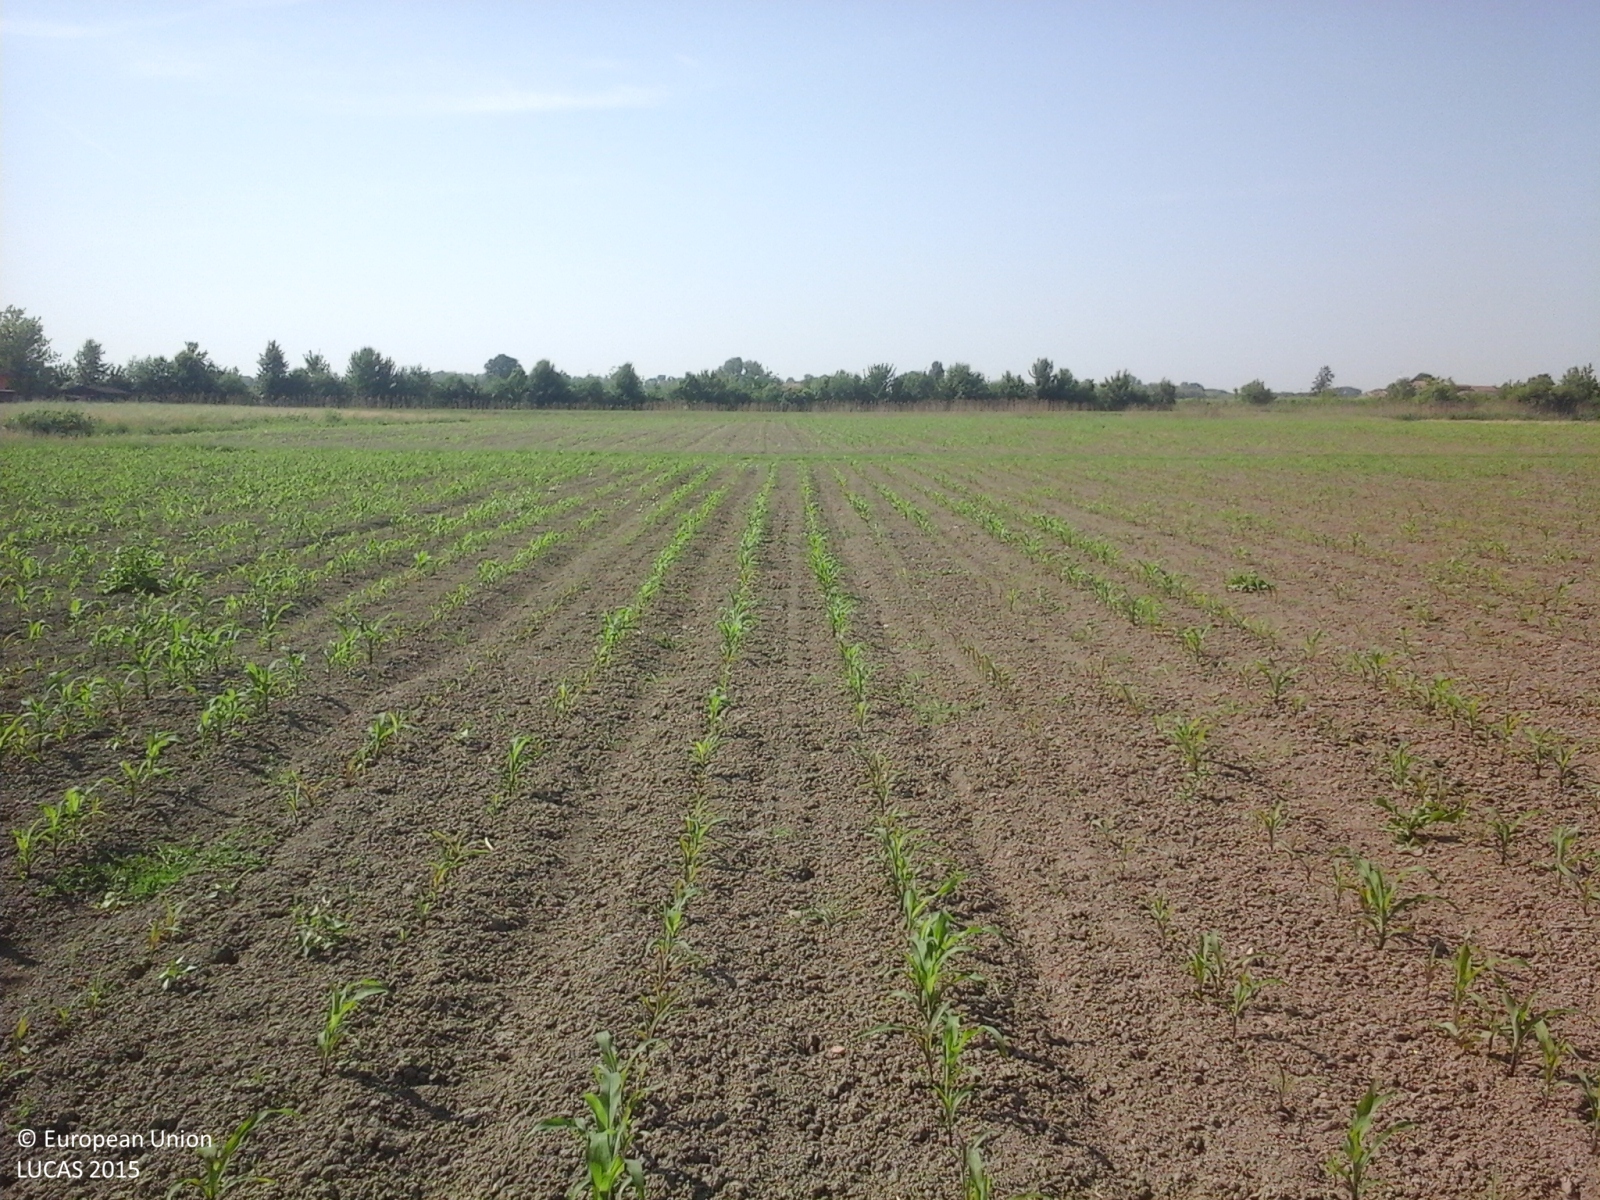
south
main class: Cropland
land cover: Maize
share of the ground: 10 - 25 %
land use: Agriculture (excluding fallow land and kitchen gardens)
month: May
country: IT
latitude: 45.0493
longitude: 10.9758
